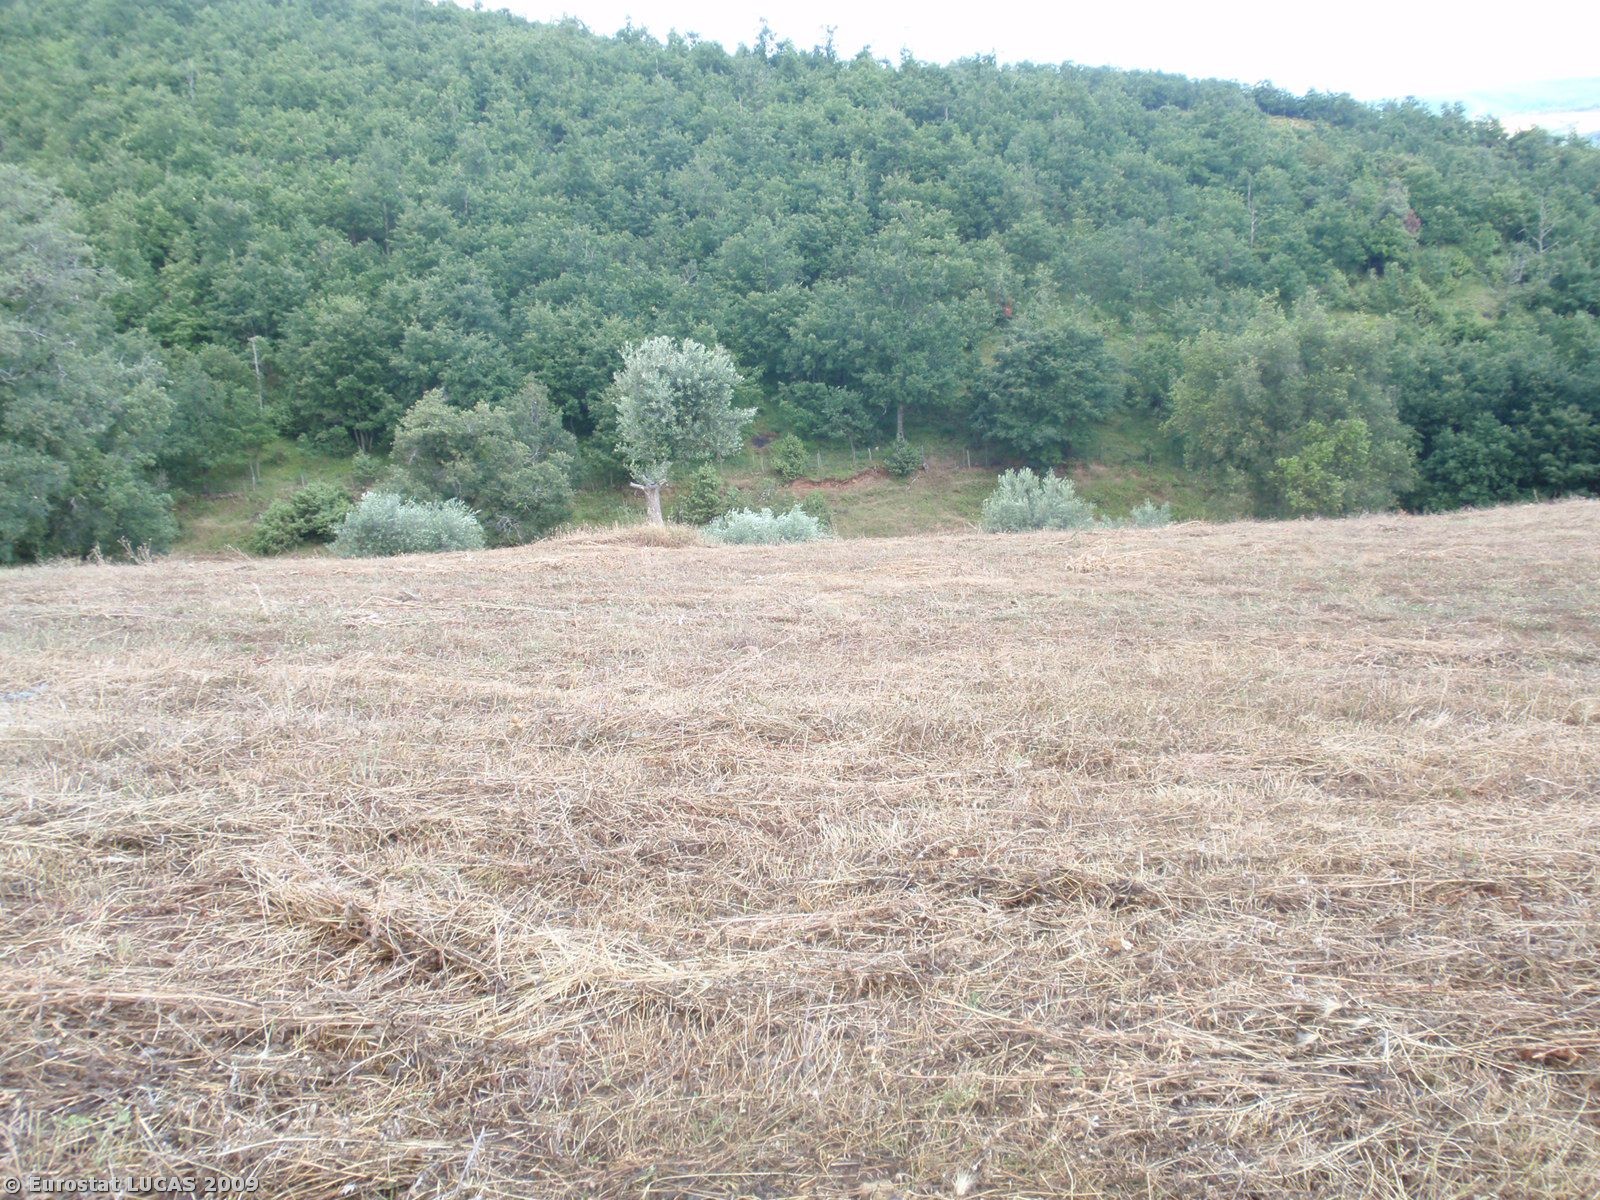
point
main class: Cropland
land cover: Temporary grasslands
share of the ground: < 10 %
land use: Agriculture (excluding fallow land and kitchen gardens)
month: June
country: IT
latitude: 40.2768
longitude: 16.1027
